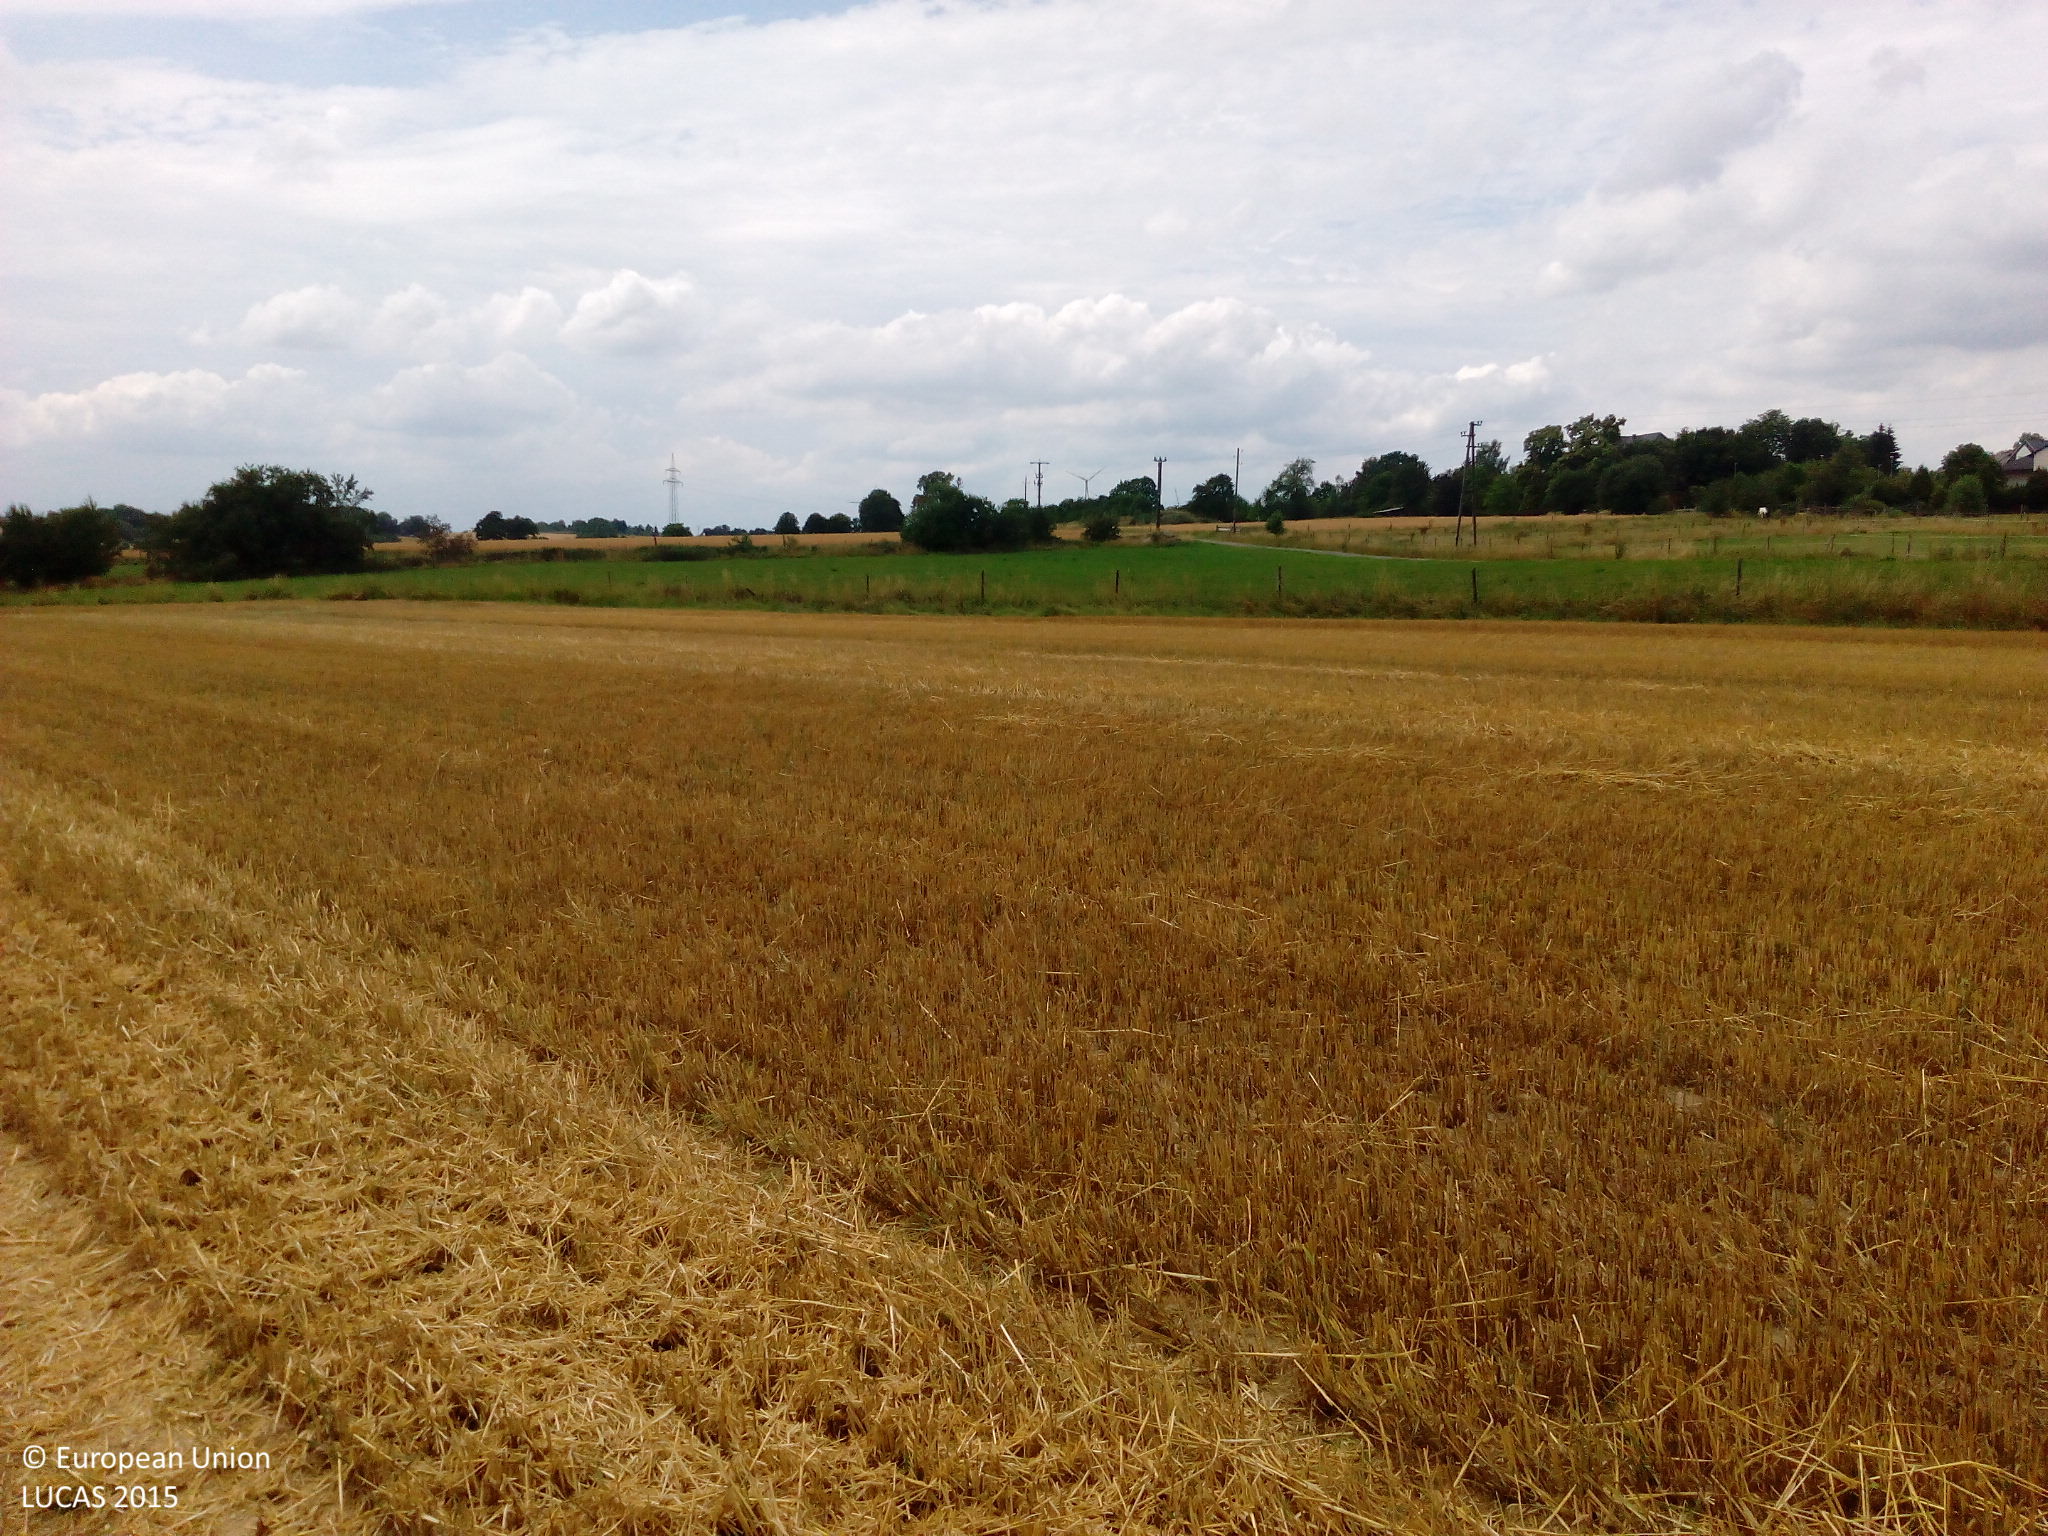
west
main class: Cropland
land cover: Barley
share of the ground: < 10 %
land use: Agriculture (excluding fallow land and kitchen gardens)
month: July
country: DE
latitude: 49.9770
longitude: 7.5043
